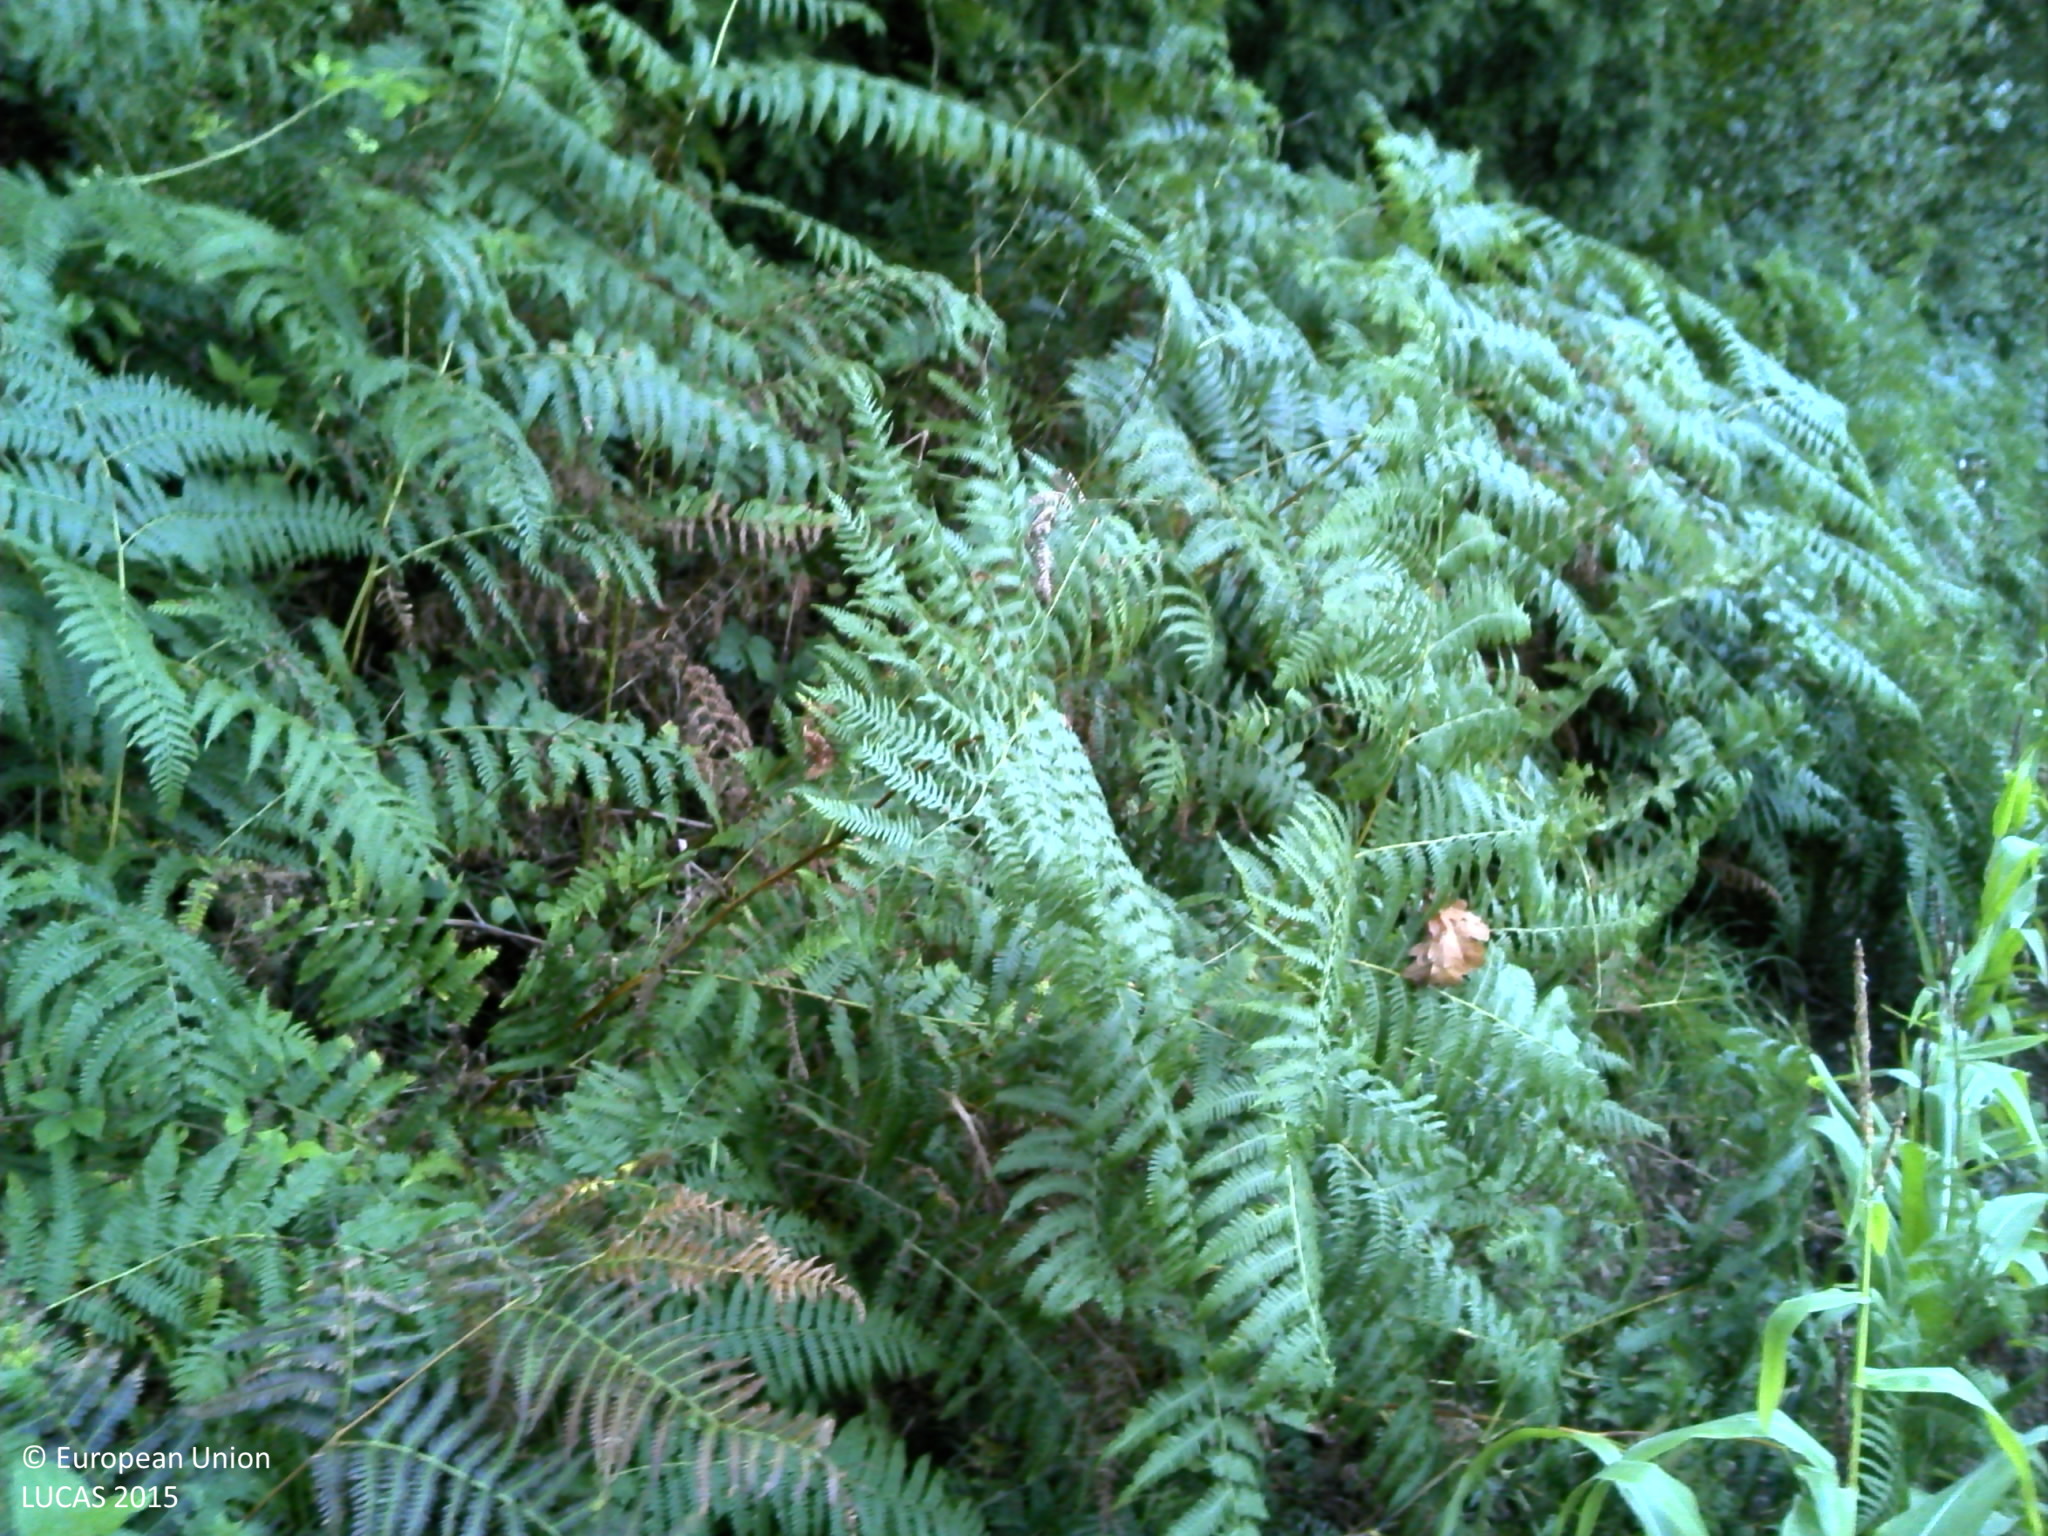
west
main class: Cropland
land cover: Maize
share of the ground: > 75 %
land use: Agriculture (excluding fallow land and kitchen gardens)
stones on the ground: < 10 %
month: September
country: FR
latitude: 48.5430
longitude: -3.7510
